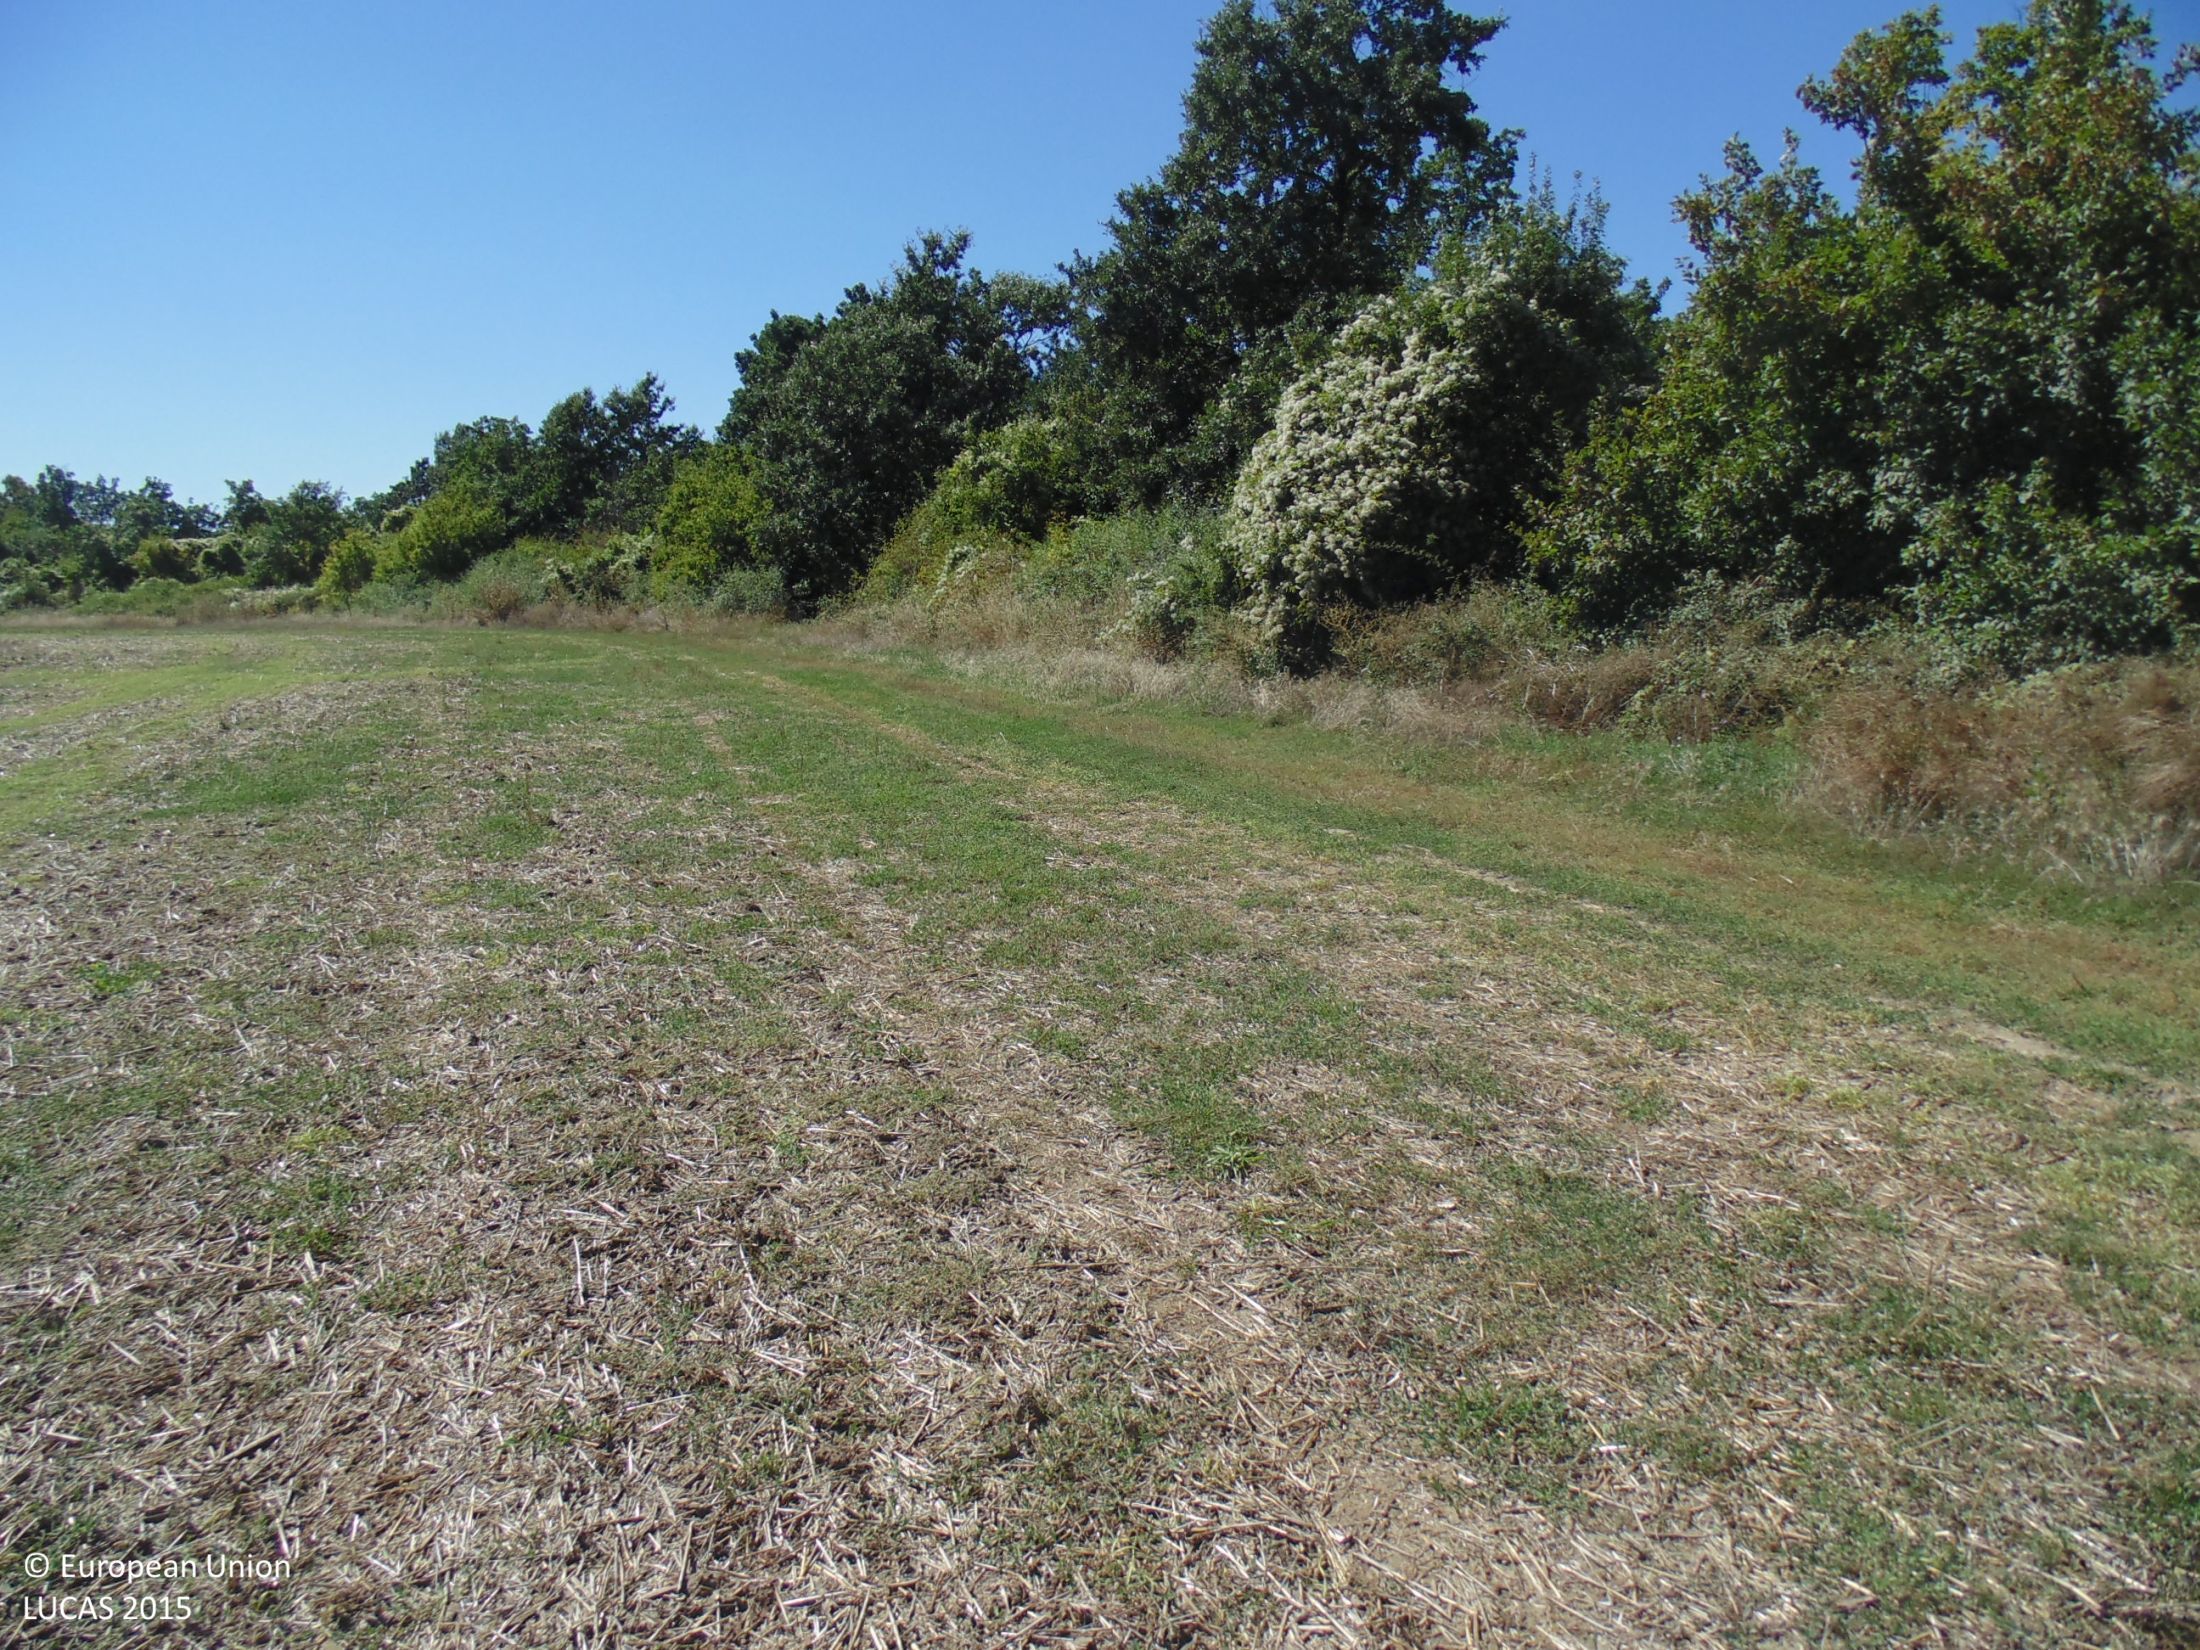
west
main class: Cropland
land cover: Common wheat
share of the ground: < 10 %
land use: Agriculture (excluding fallow land and kitchen gardens)
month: September
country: BG
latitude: 43.7333
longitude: 27.0691
